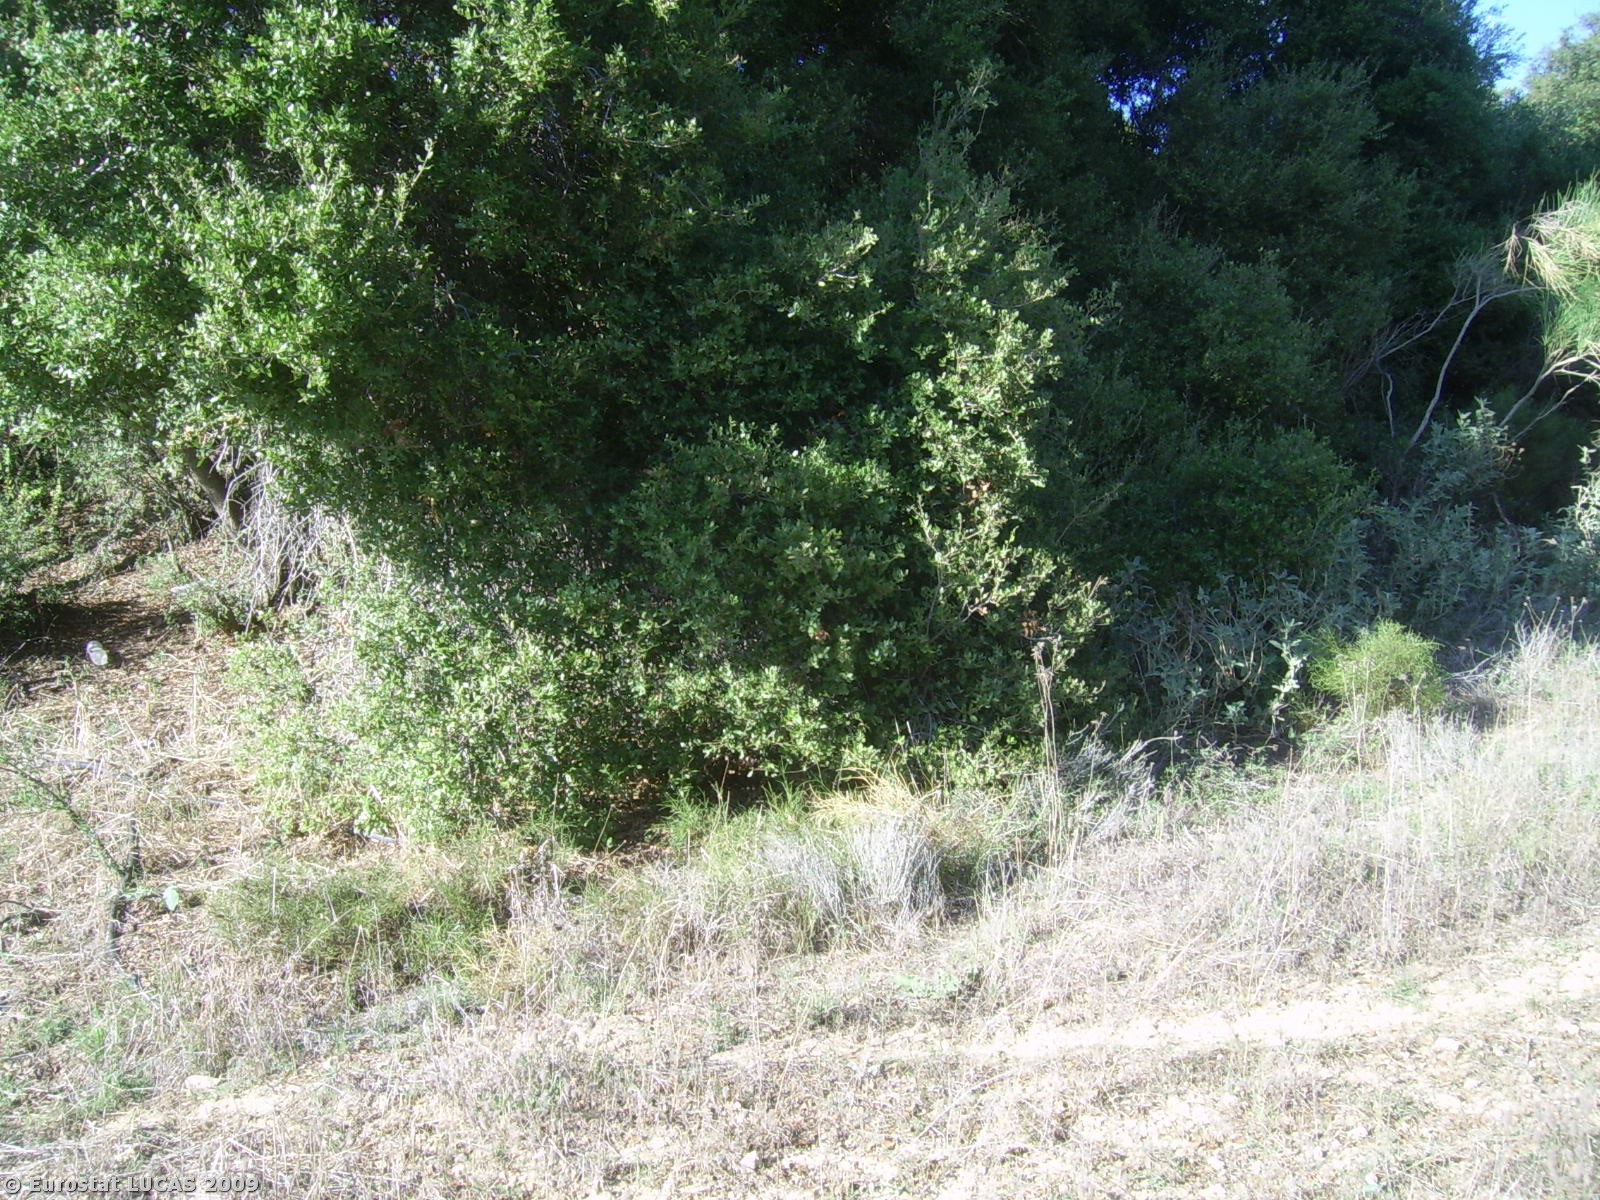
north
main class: Woodland
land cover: Broadleaved woodland
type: hemiboreal forest and nemoral coniferous forest and mixed broadleaved-coniferous forest
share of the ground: > 75 %
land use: Forestry
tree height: > 5 m
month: October
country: GR
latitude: 37.9283
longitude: 21.3268
